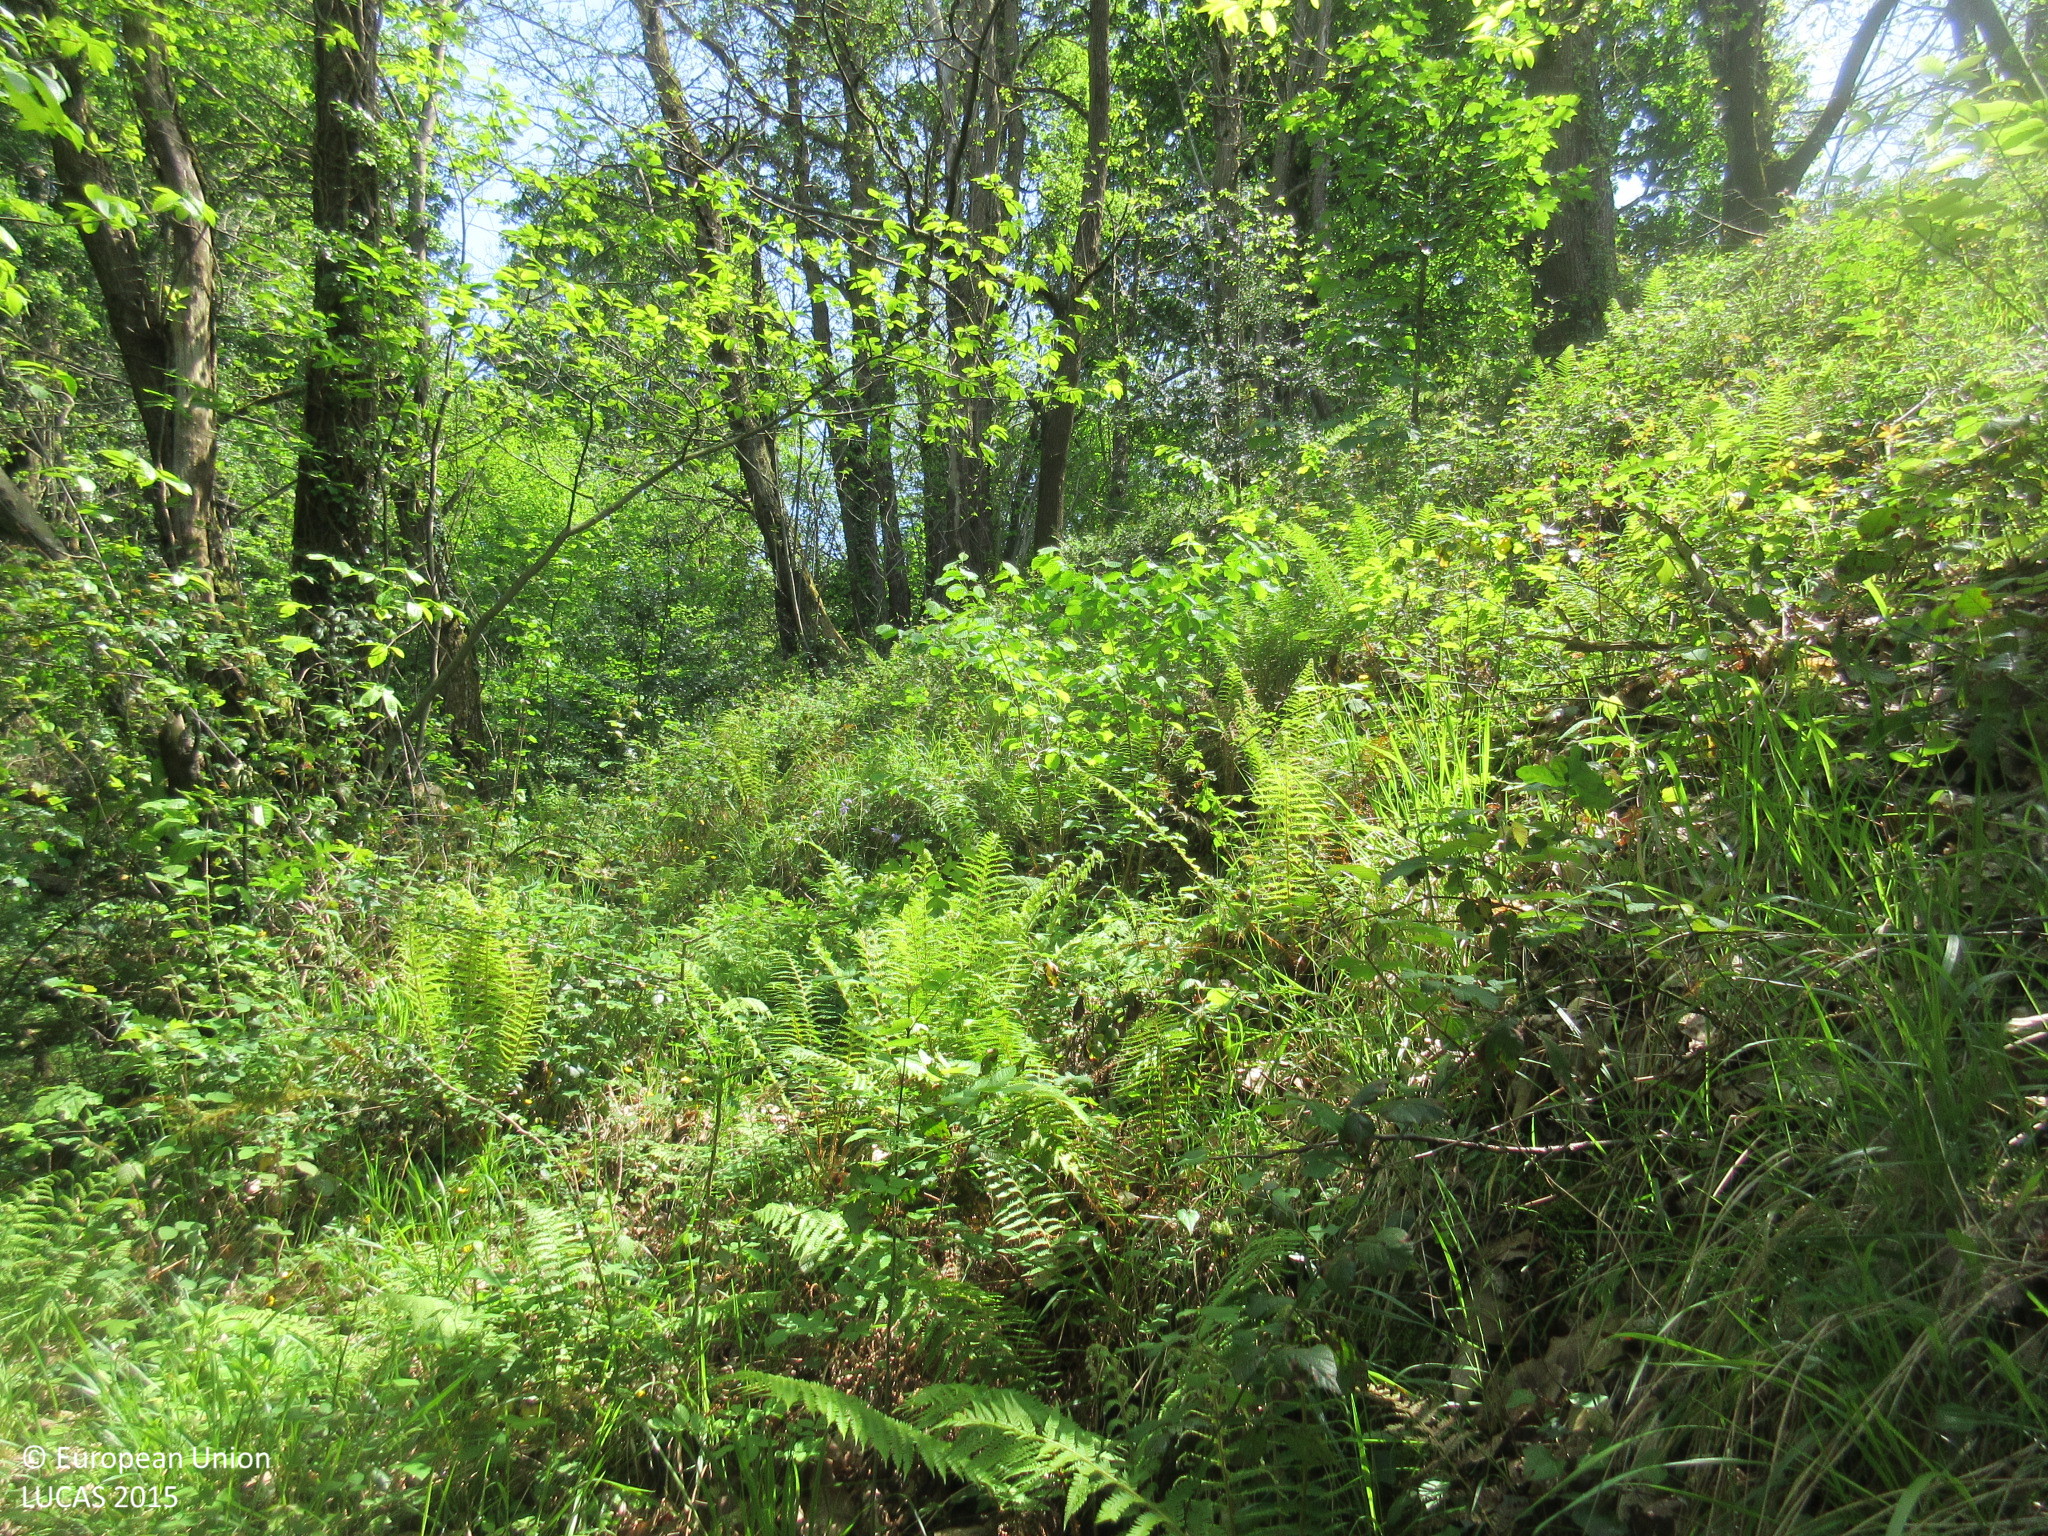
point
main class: Woodland
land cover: Broadleaved woodland
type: thermophilous deciduous forest
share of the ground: > 75 %
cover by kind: broadleaved forest trees 100 %
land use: Semi-natural and natural areas not in use
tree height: > 5 m
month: May
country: ES
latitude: 43.3058
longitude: -5.8548
